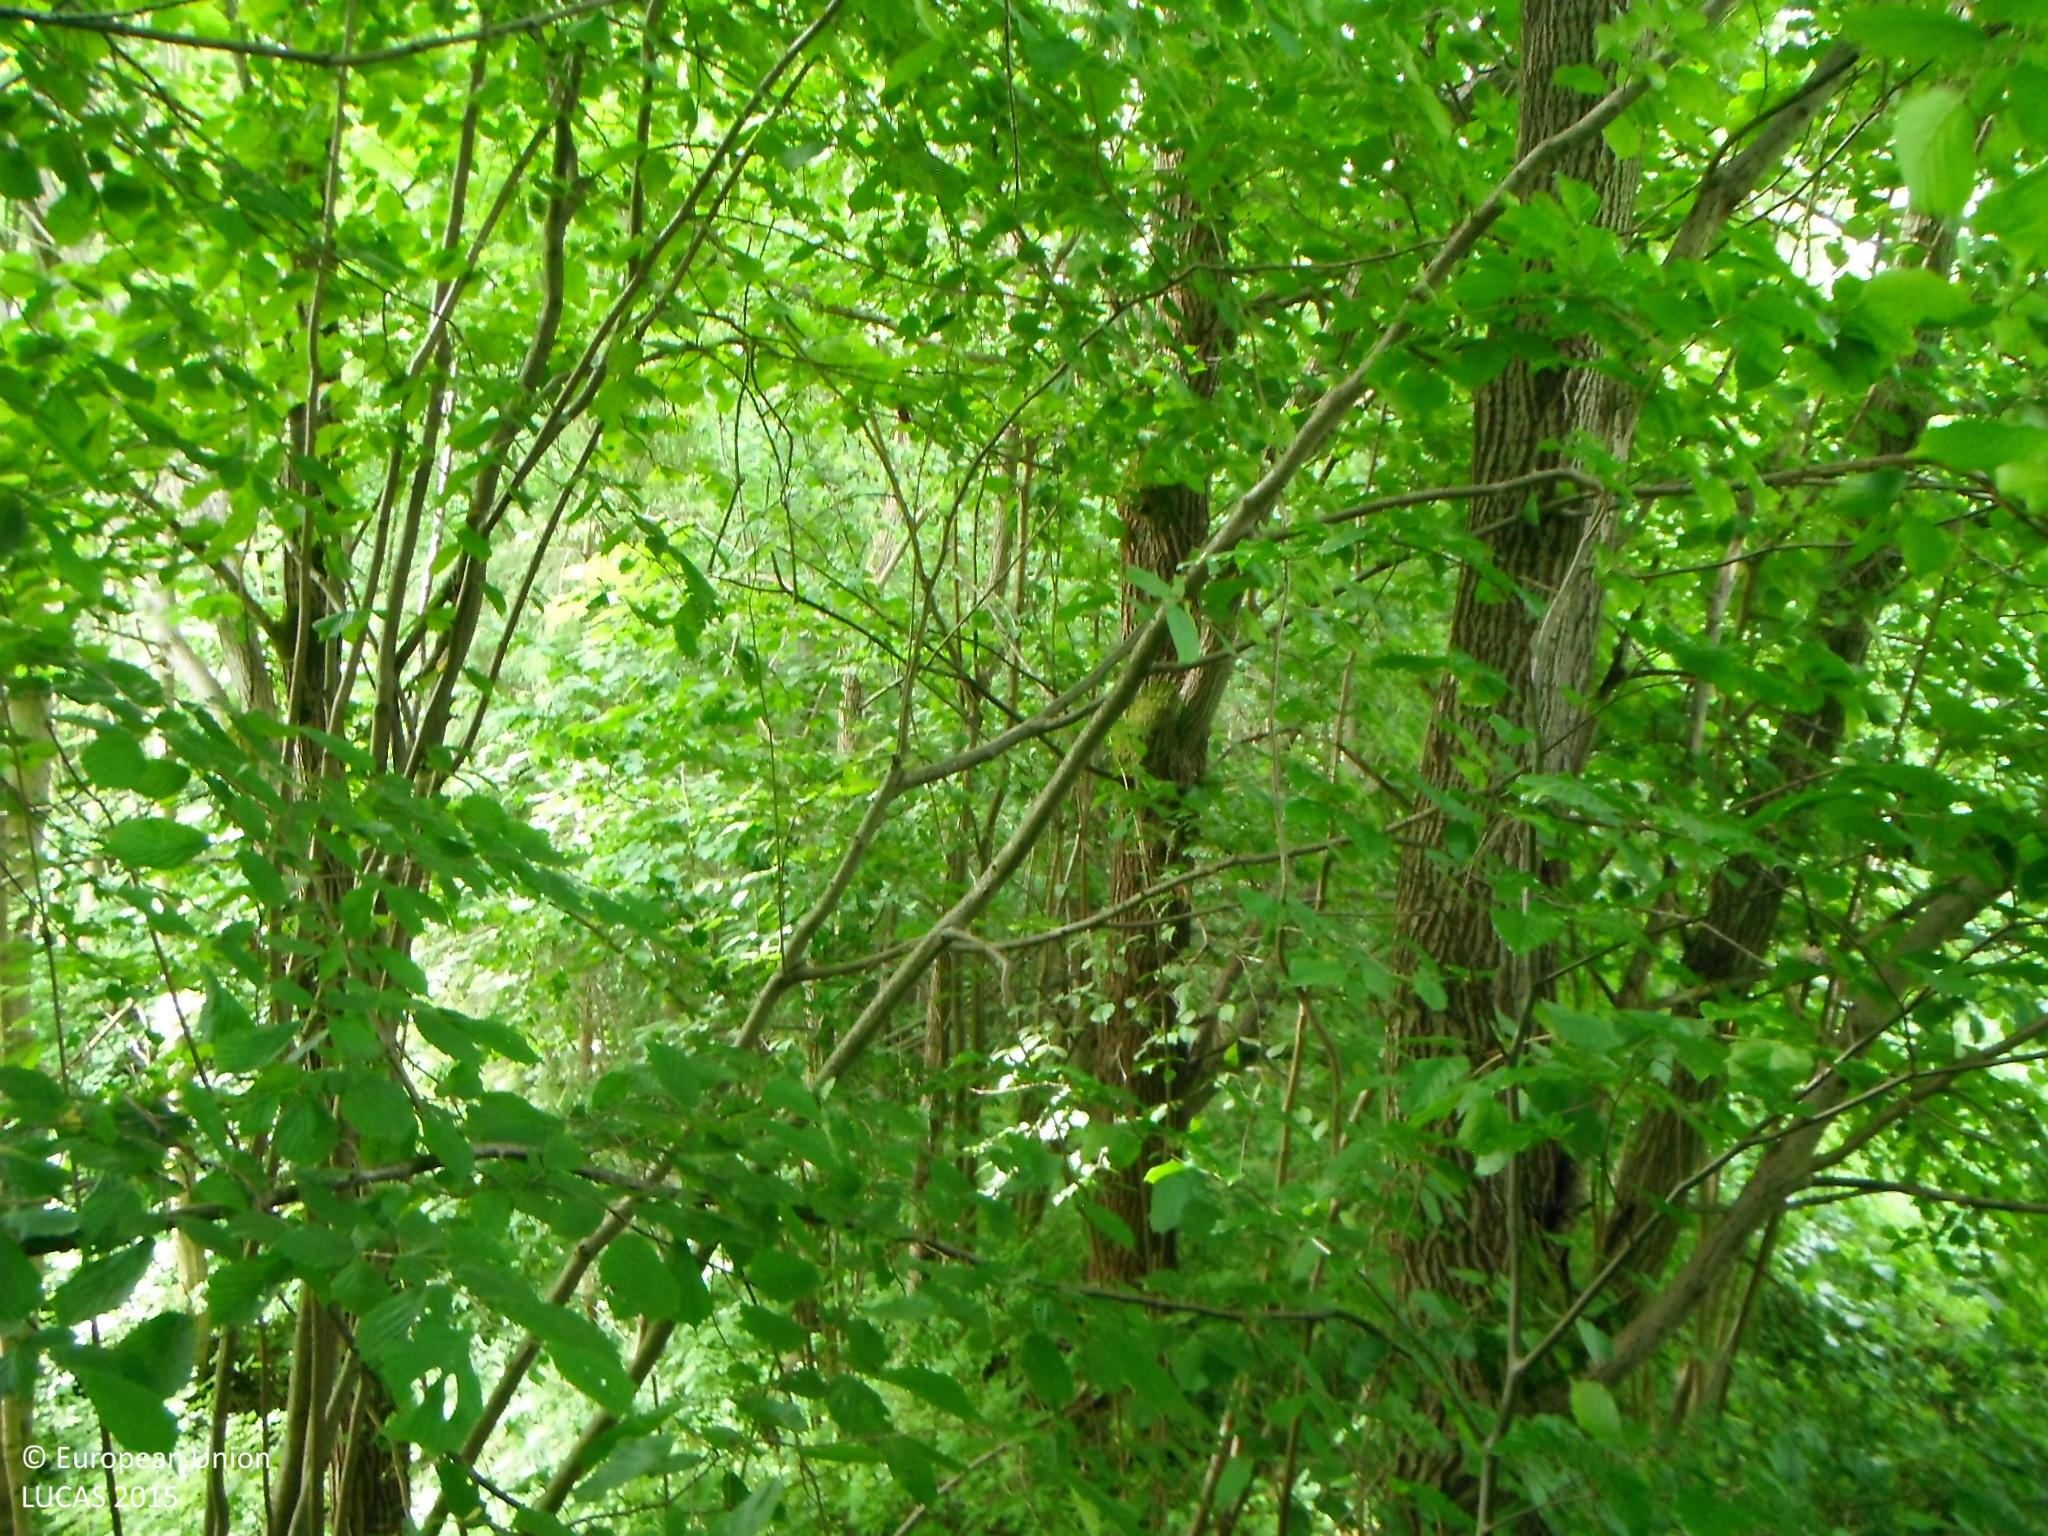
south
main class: Woodland
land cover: Broadleaved woodland
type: mesophytic deciduous forest
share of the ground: > 75 %
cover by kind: broadleaved forest trees 100 %
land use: Semi-natural and natural areas not in use
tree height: > 5 m
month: July
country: SK
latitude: 49.2939
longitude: 19.1118
